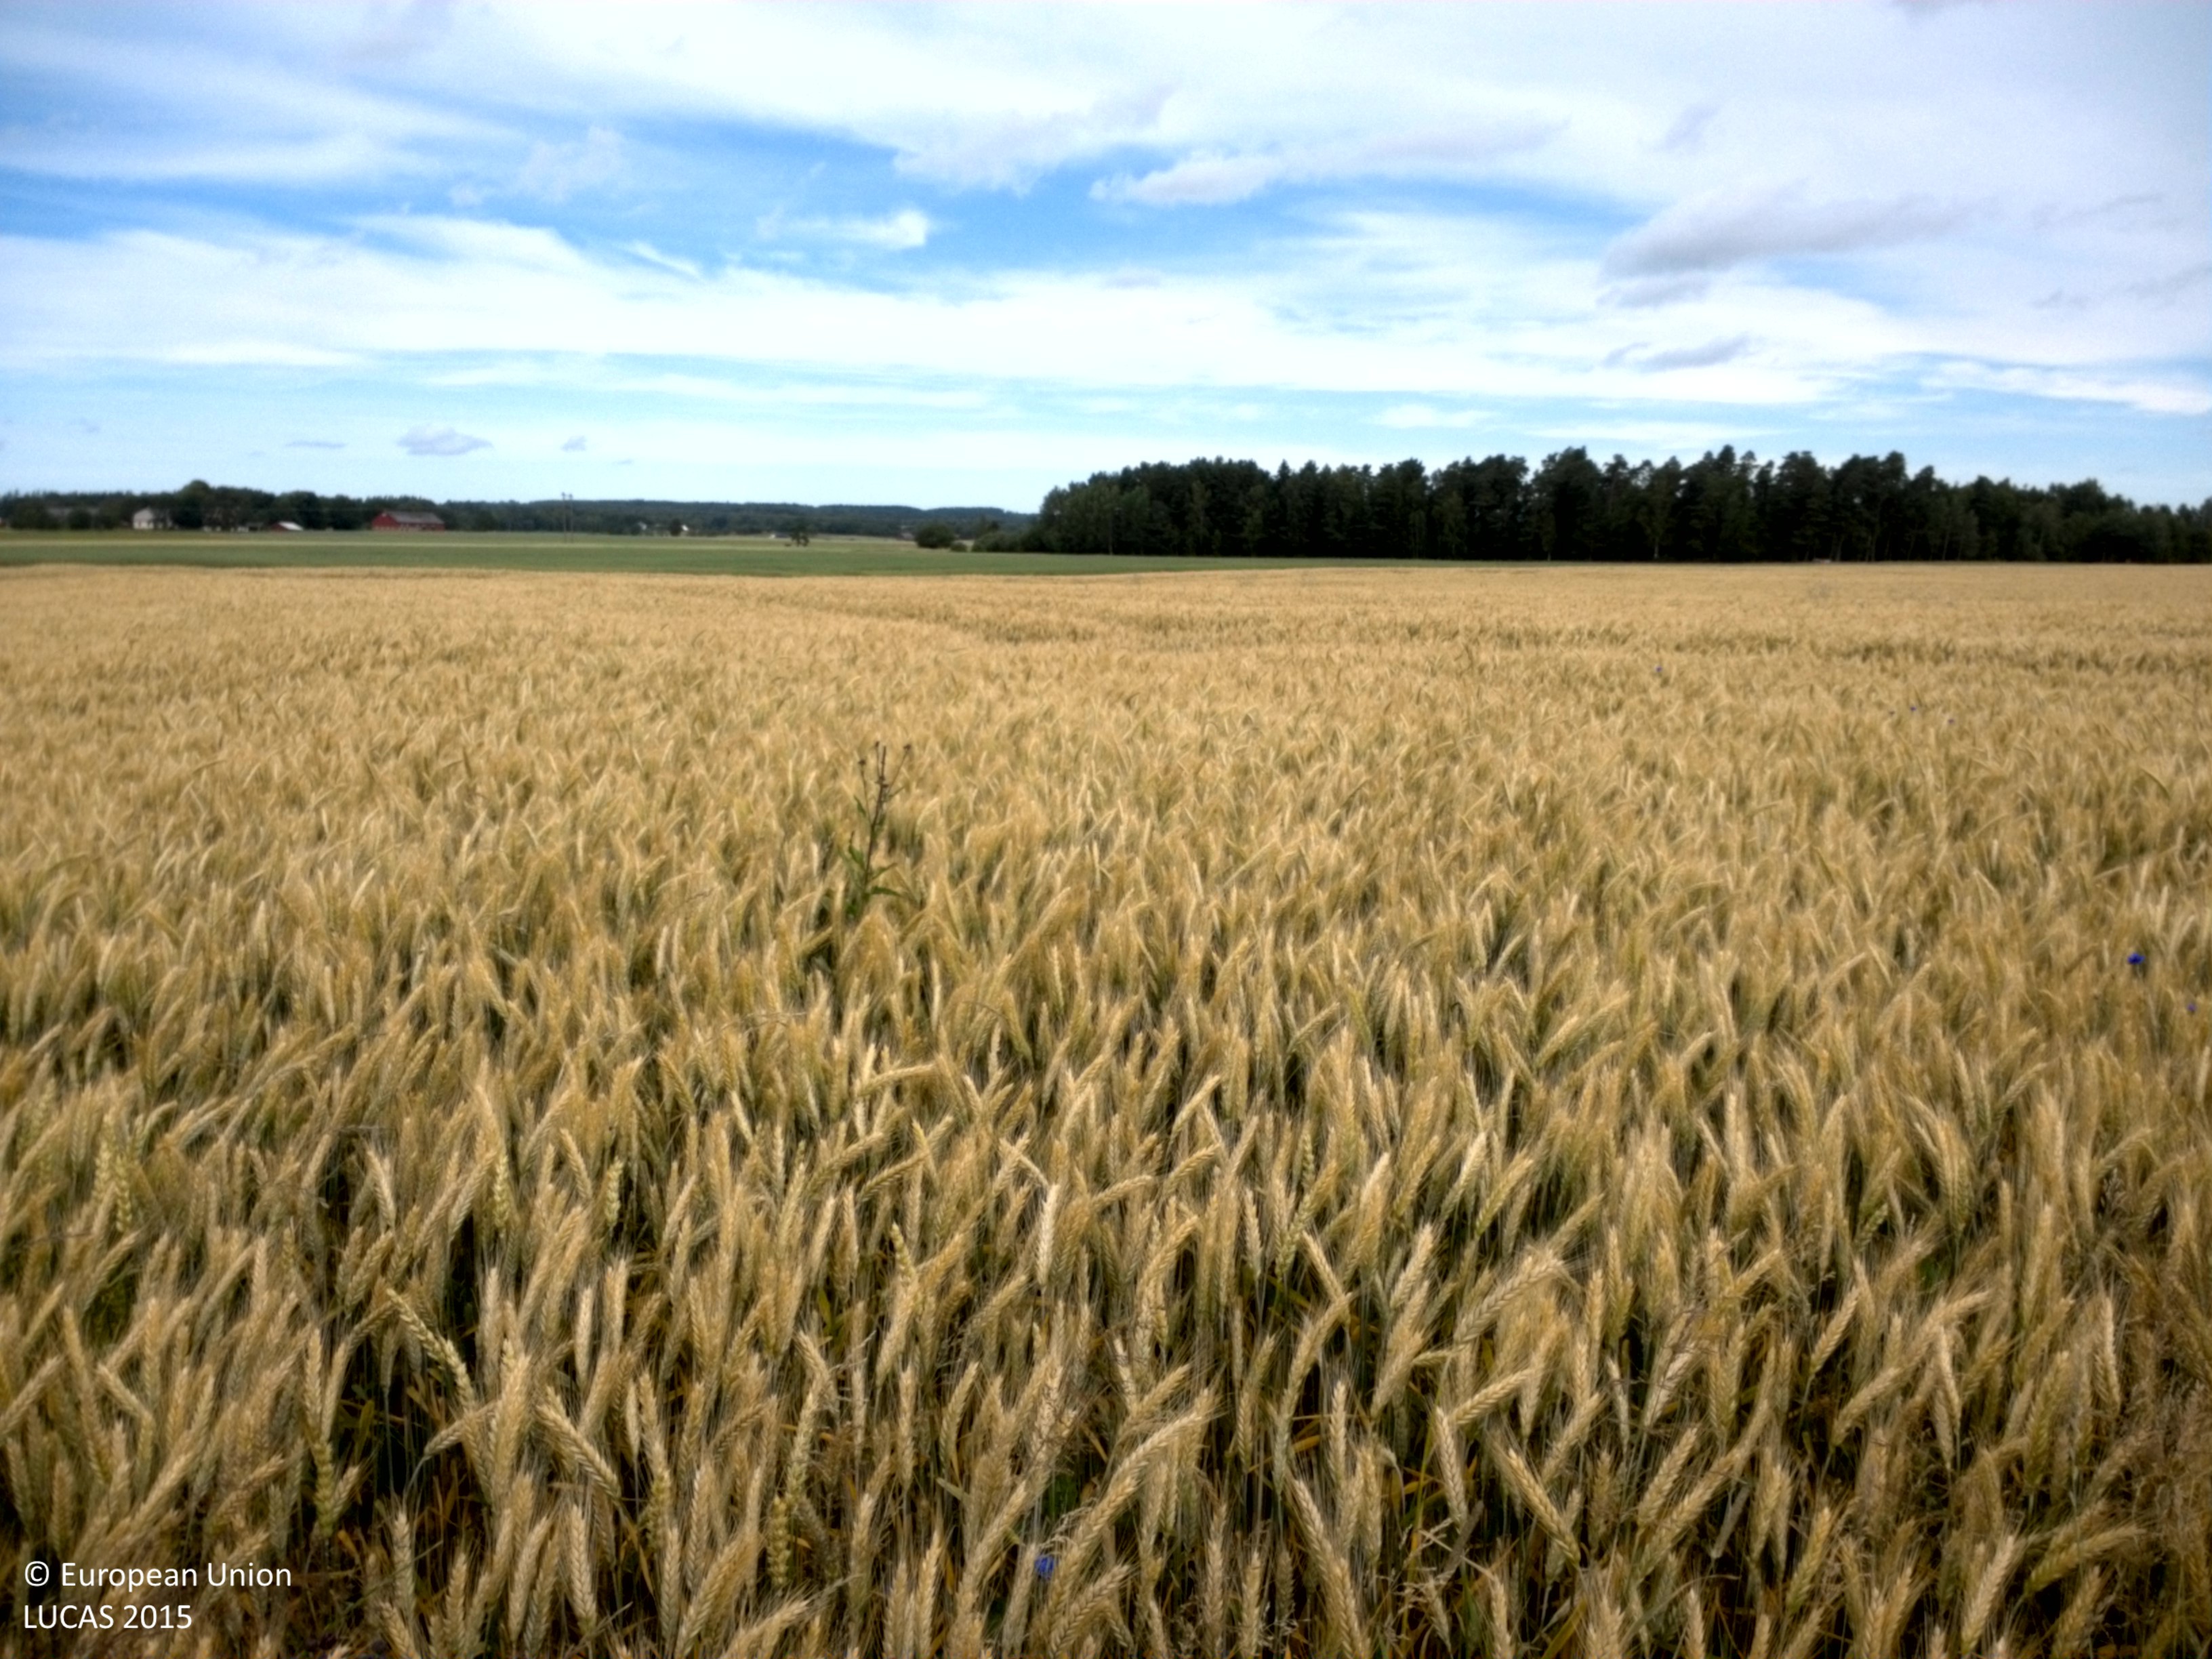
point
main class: Cropland
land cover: Oats
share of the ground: > 75 %
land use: Agriculture (excluding fallow land and kitchen gardens)
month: July
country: SE
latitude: 58.5013
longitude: 13.3744
